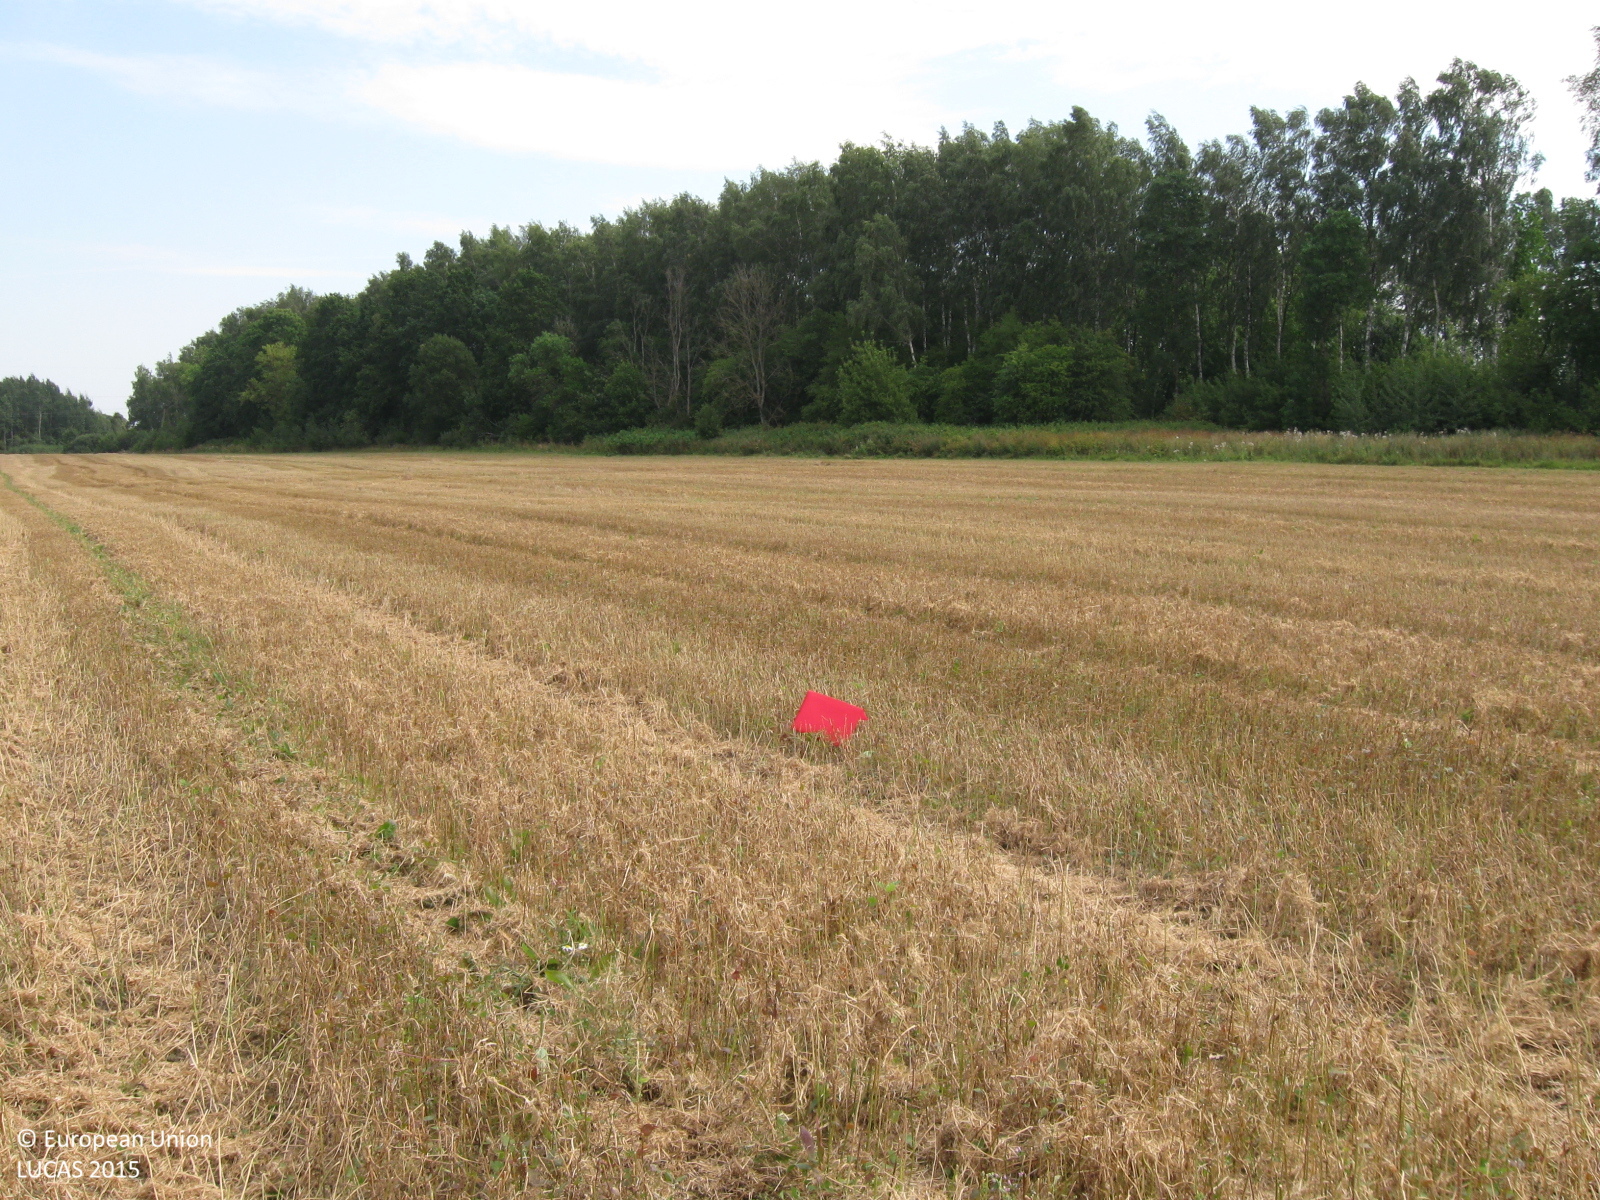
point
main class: Cropland
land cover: Dry pulses
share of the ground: > 75 %
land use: Agriculture (excluding fallow land and kitchen gardens)
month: August
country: LT
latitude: 55.4688
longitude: 22.9931
